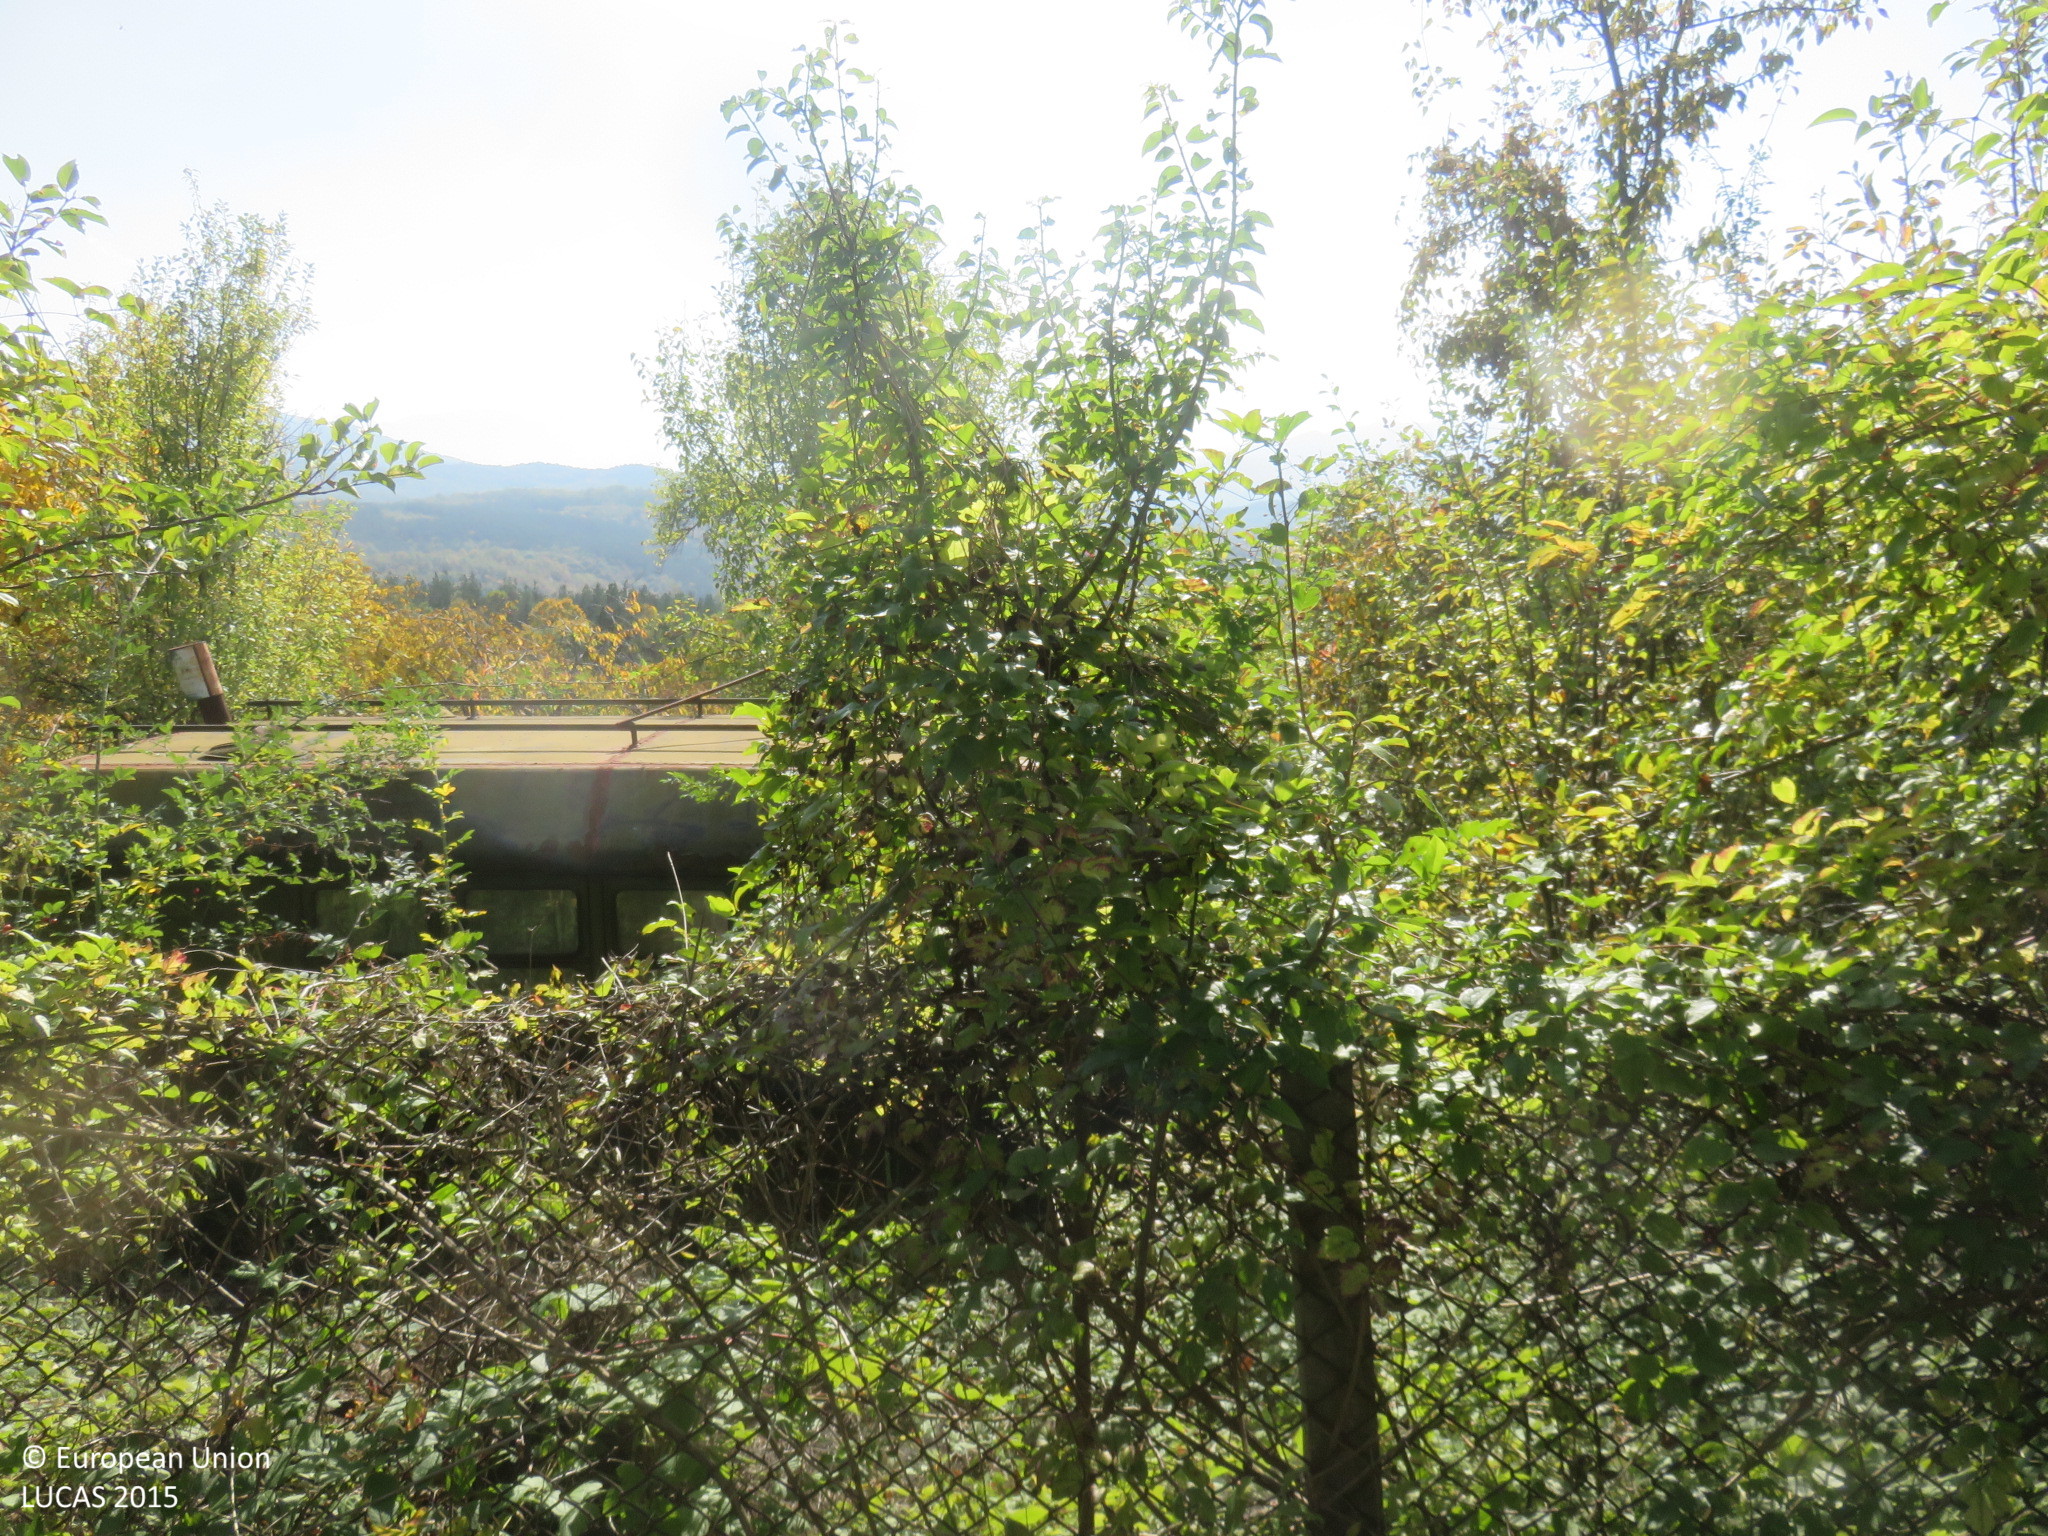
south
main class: Shrubland
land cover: Shrubland with sparse tree cover
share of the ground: 50 - 75 %
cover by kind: shrubs 75 %, herbaceous plants 20 %, broadleaved forest trees 5 %
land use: Residential
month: October
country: BG
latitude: 42.9269
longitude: 24.8506
